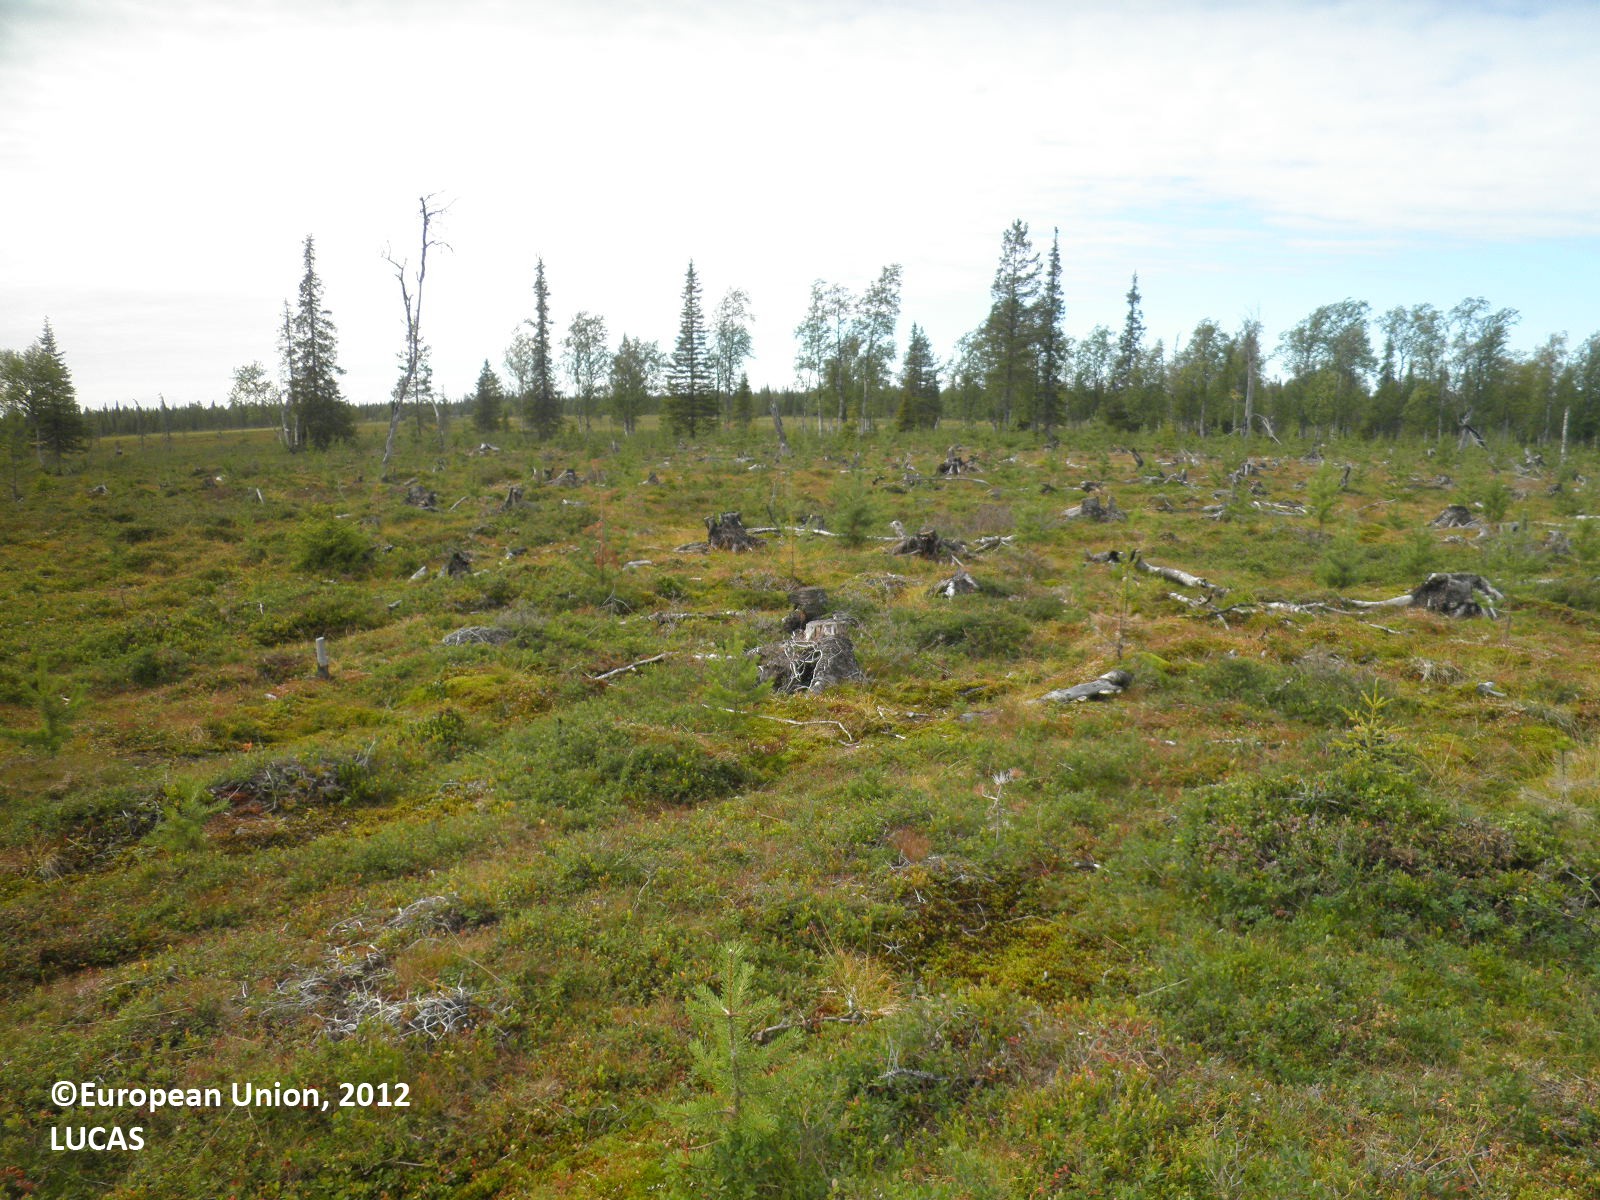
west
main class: Grassland
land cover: Grassland with sparse tree/shrub cover
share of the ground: > 75 %
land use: Forestry
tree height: < 5 m
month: August
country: FI
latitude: 67.7609
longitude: 26.3288
